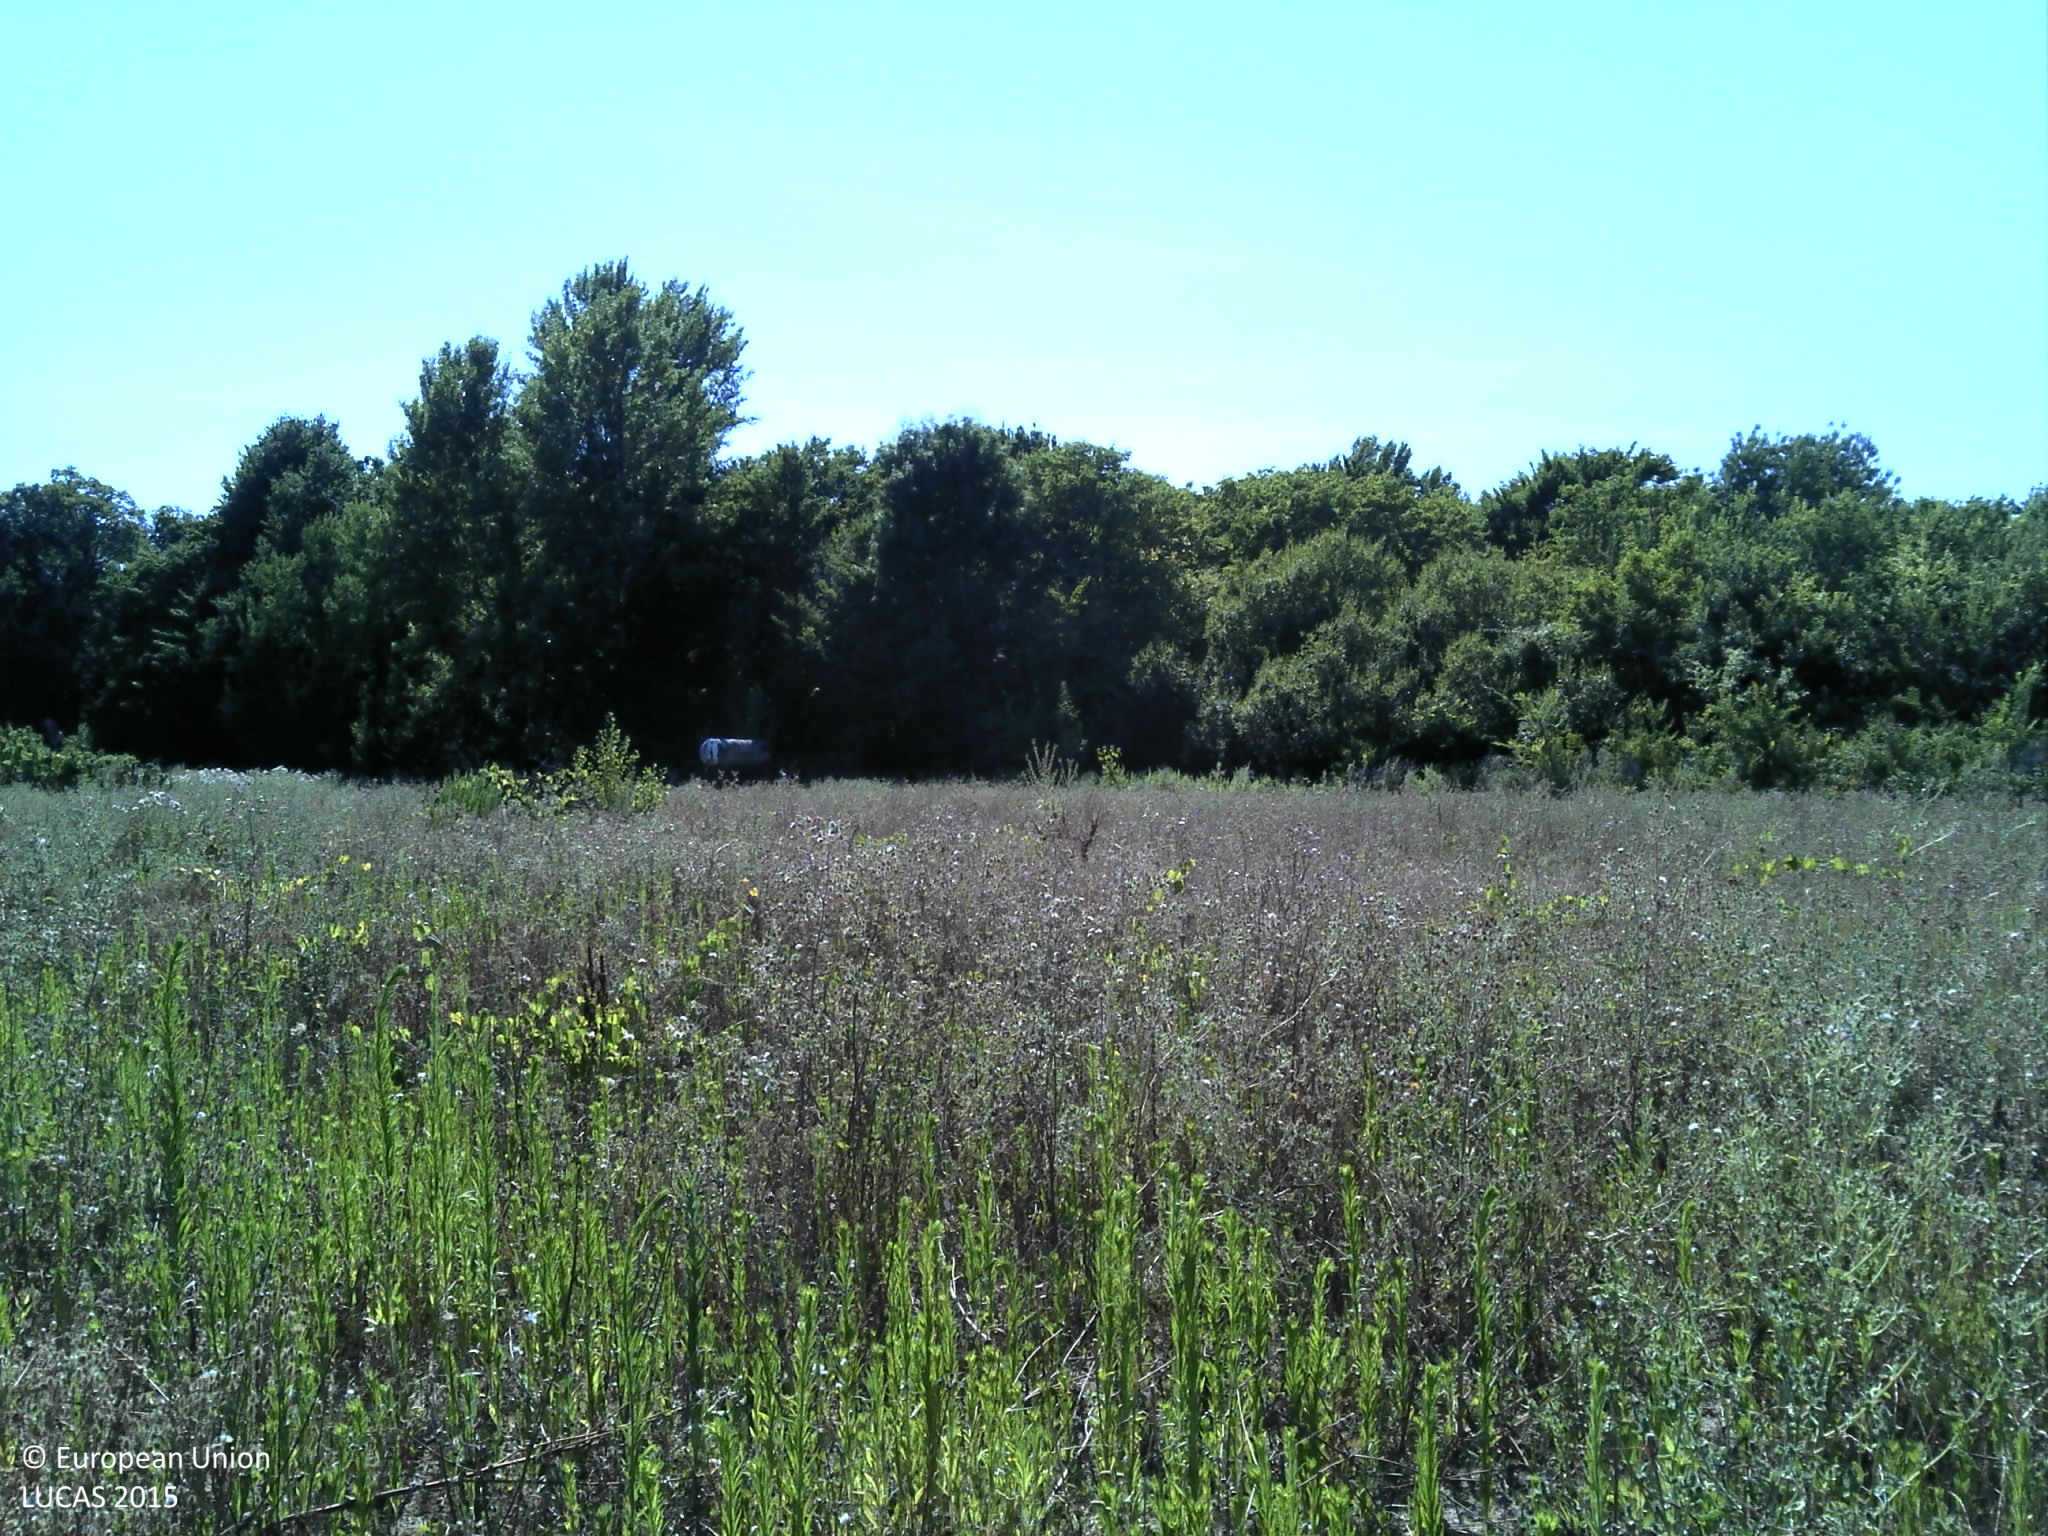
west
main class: Grassland
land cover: Spontaneously vegetated surfaces
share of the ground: > 75 %
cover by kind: herbaceous plants 100 %
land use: Abandoned areas
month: July
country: FR
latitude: 44.9100
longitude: -0.4674
